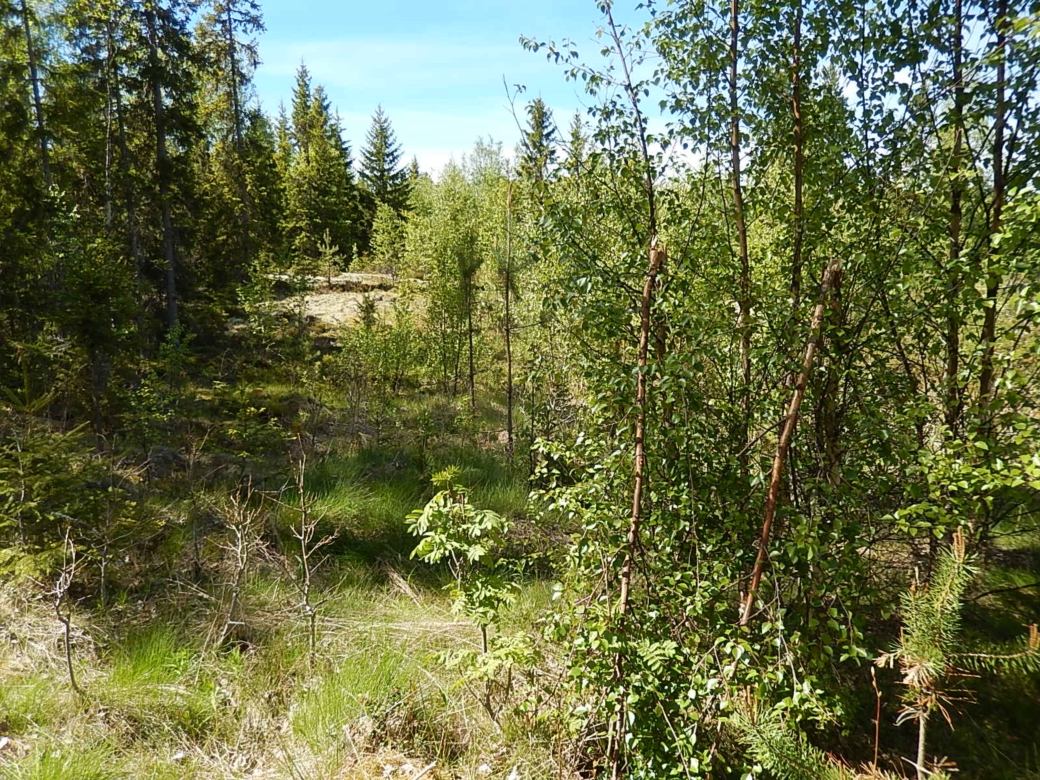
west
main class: Woodland
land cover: Other mixed woodland
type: boreal forest
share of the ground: 50 - 75 %
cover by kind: herbaceous plants 35 %, broadleaved forest trees 30 %, coniferous forest trees 20 %, lichens and mosses 10 %, shrubs 5 %
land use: Forestry
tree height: > 5 m
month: June
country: FI
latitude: 62.0987
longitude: 21.4821
